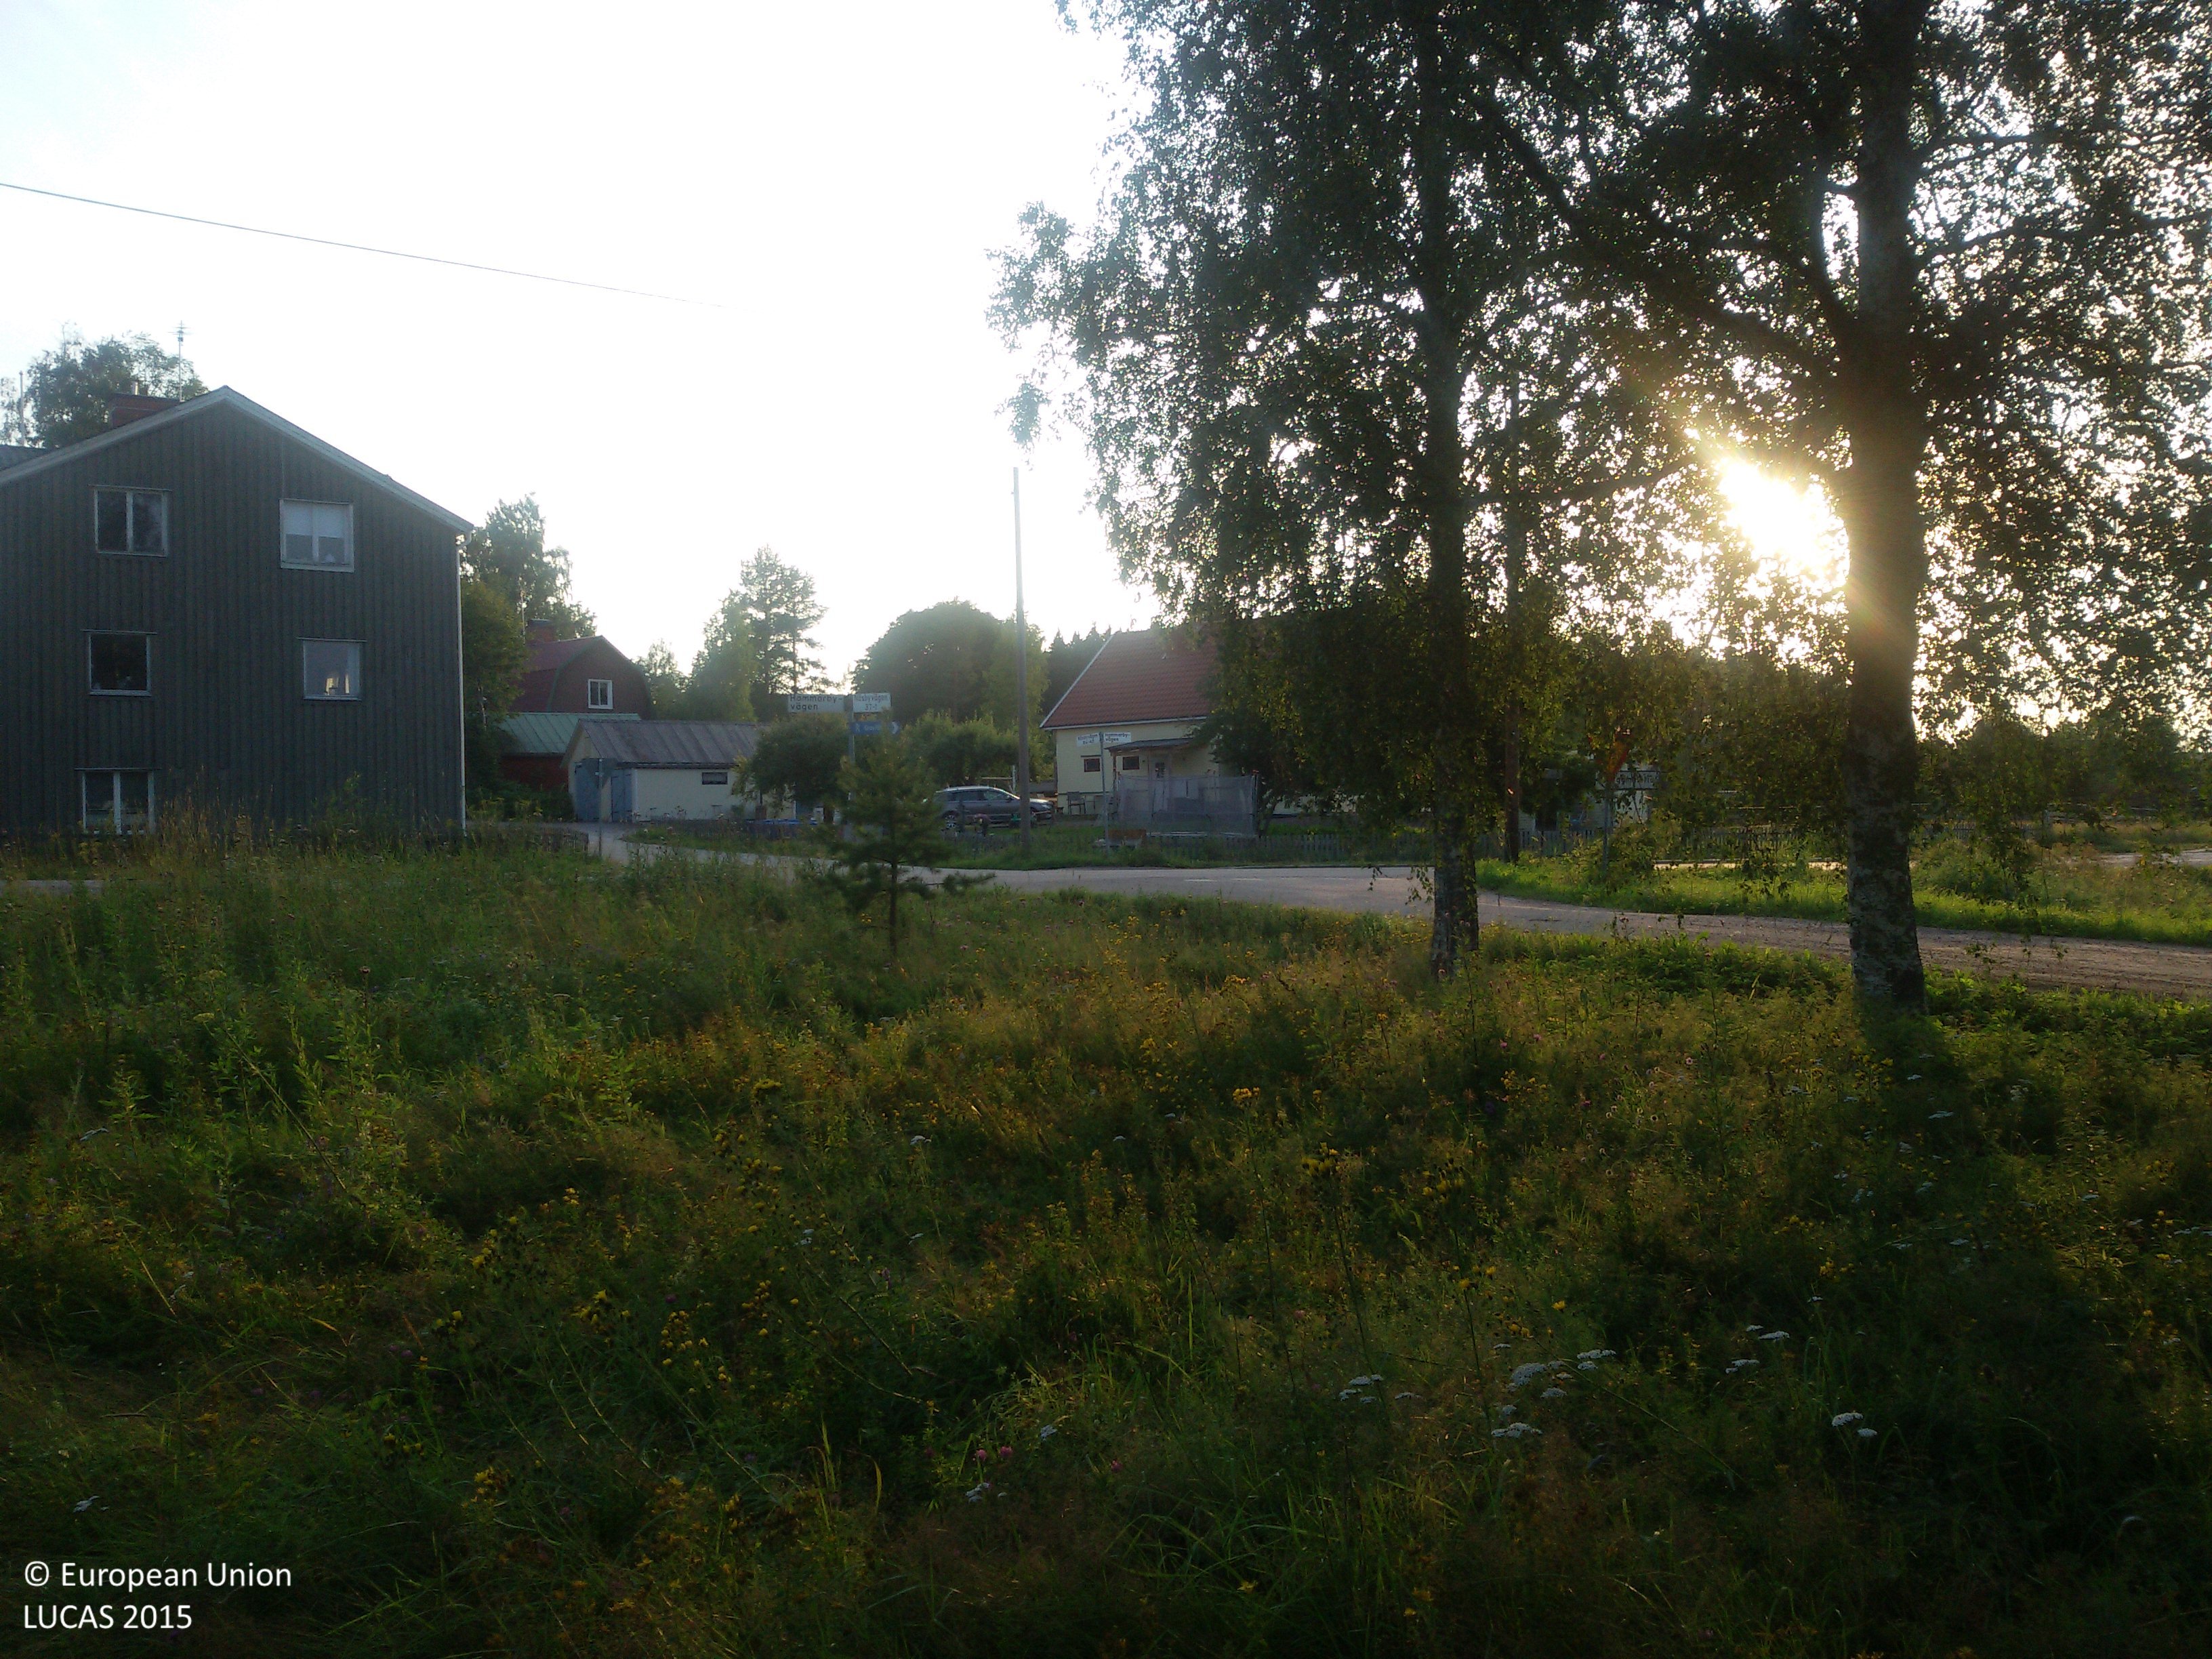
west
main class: Grassland
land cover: Grassland without tree/shrub cover
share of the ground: > 75 %
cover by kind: herbaceous plants 100 %
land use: Semi-natural and natural areas not in use
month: August
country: SE
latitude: 60.5712
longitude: 16.5384
